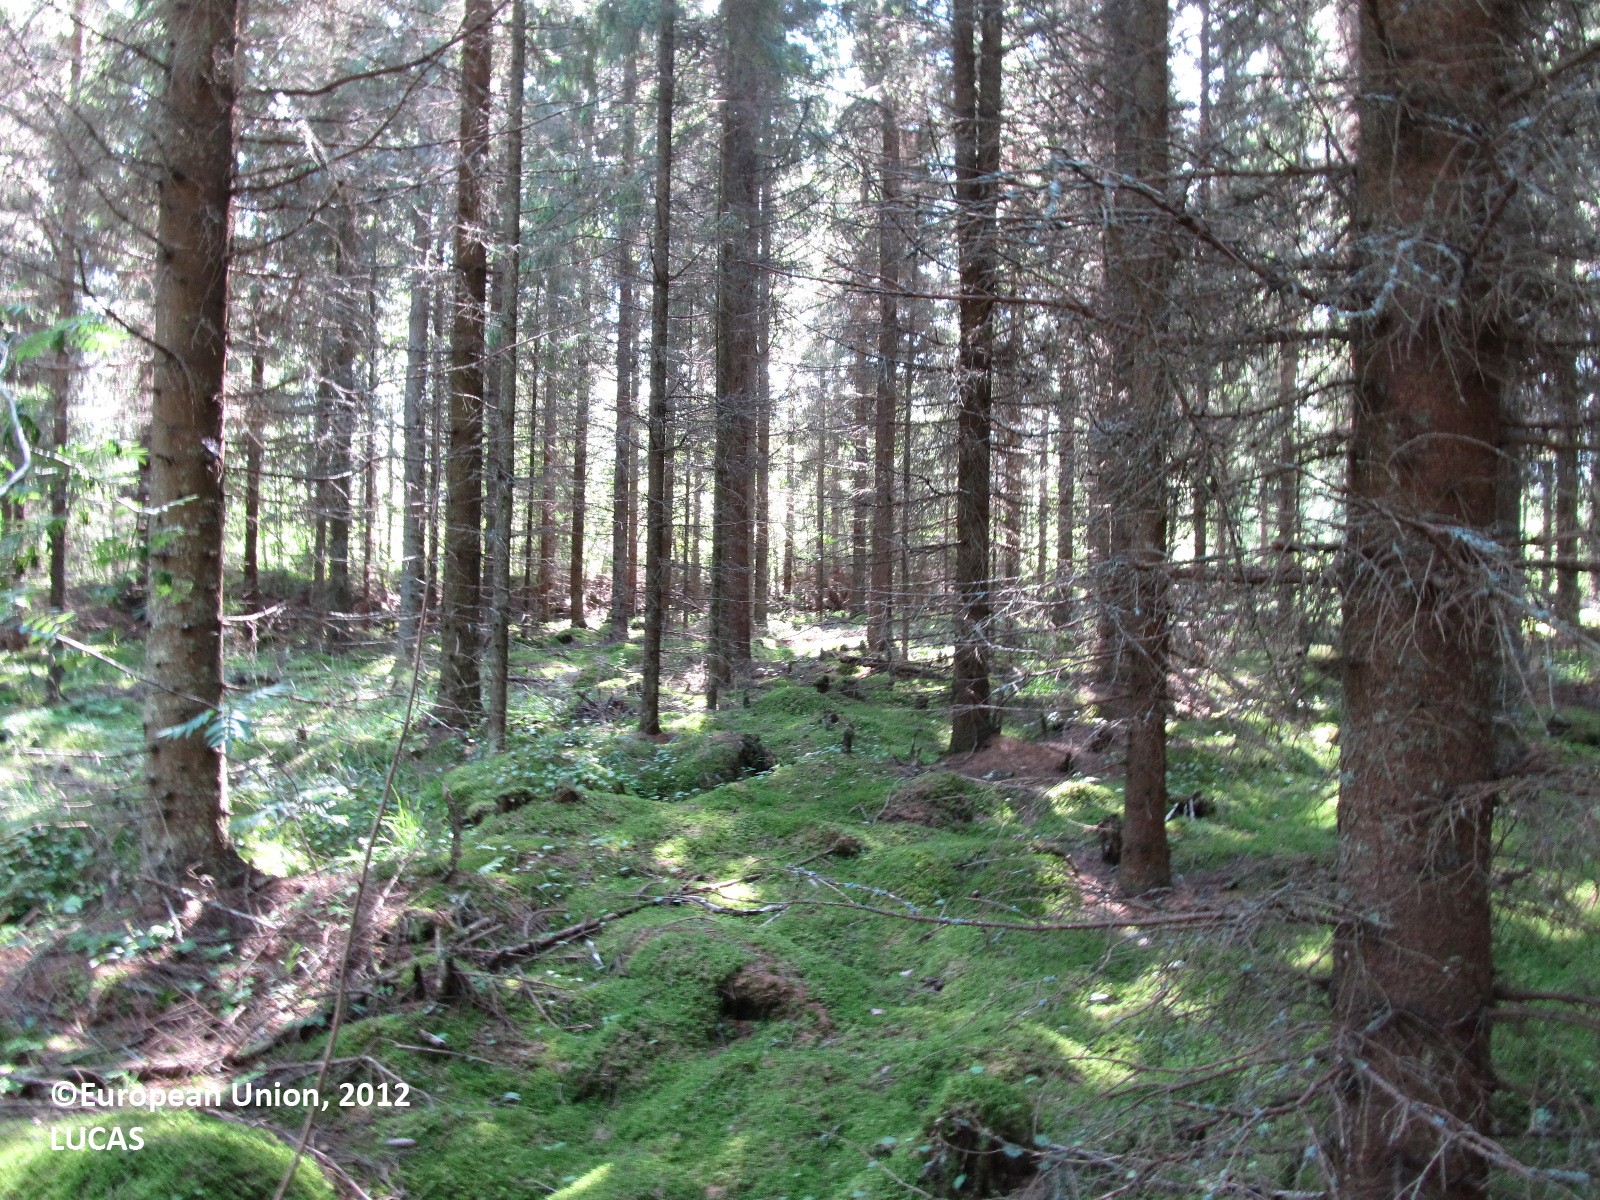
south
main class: Woodland
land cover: Spruce dominated coniferous woodland
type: boreal forest
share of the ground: 25 - 50 %
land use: Forestry
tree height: > 5 m
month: July
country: FI
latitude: 61.9828
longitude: 28.5474
